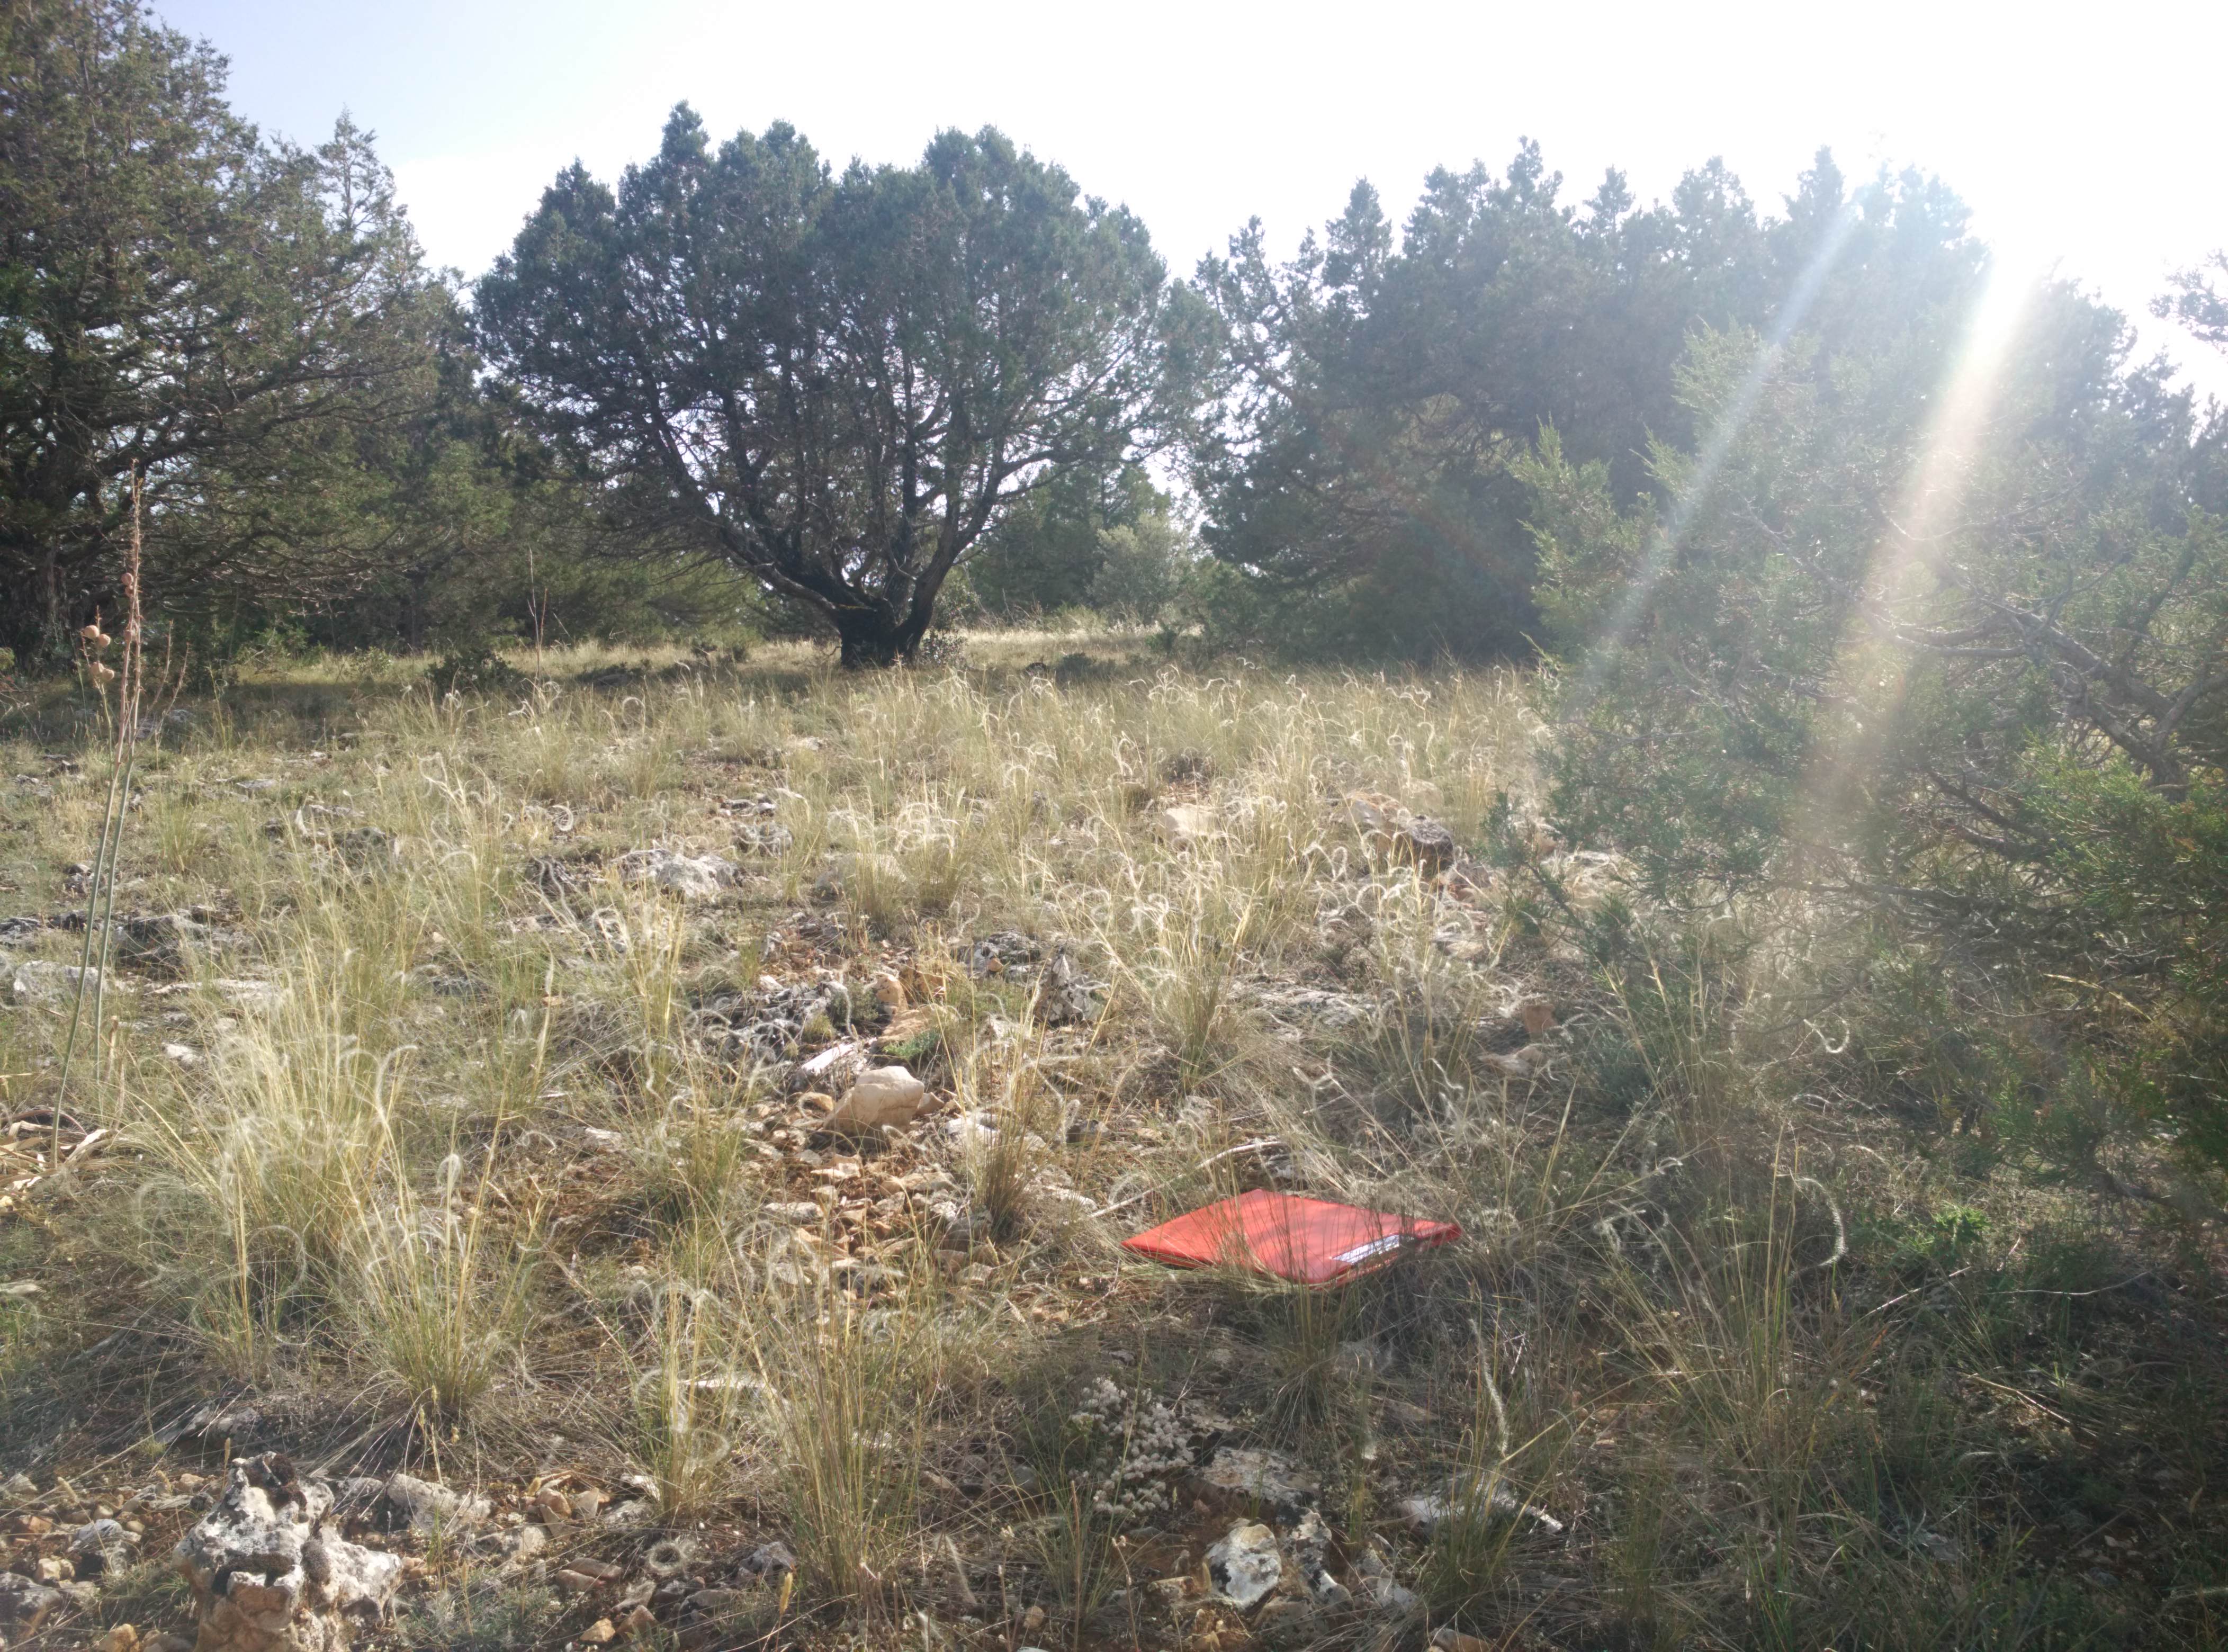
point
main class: Woodland
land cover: Other coniferous woodland
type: coniferous forest of the mediterranean region
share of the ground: 25 - 50 %
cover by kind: unconsolidated bare surface 45 %, coniferous forest trees 35 %, shrubs 10 %, broadleaved forest trees 5 %, herbaceous plants 5 %
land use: Semi-natural and natural areas not in use
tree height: > 5 m
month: July
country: ES
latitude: 41.0553
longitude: -2.0554
